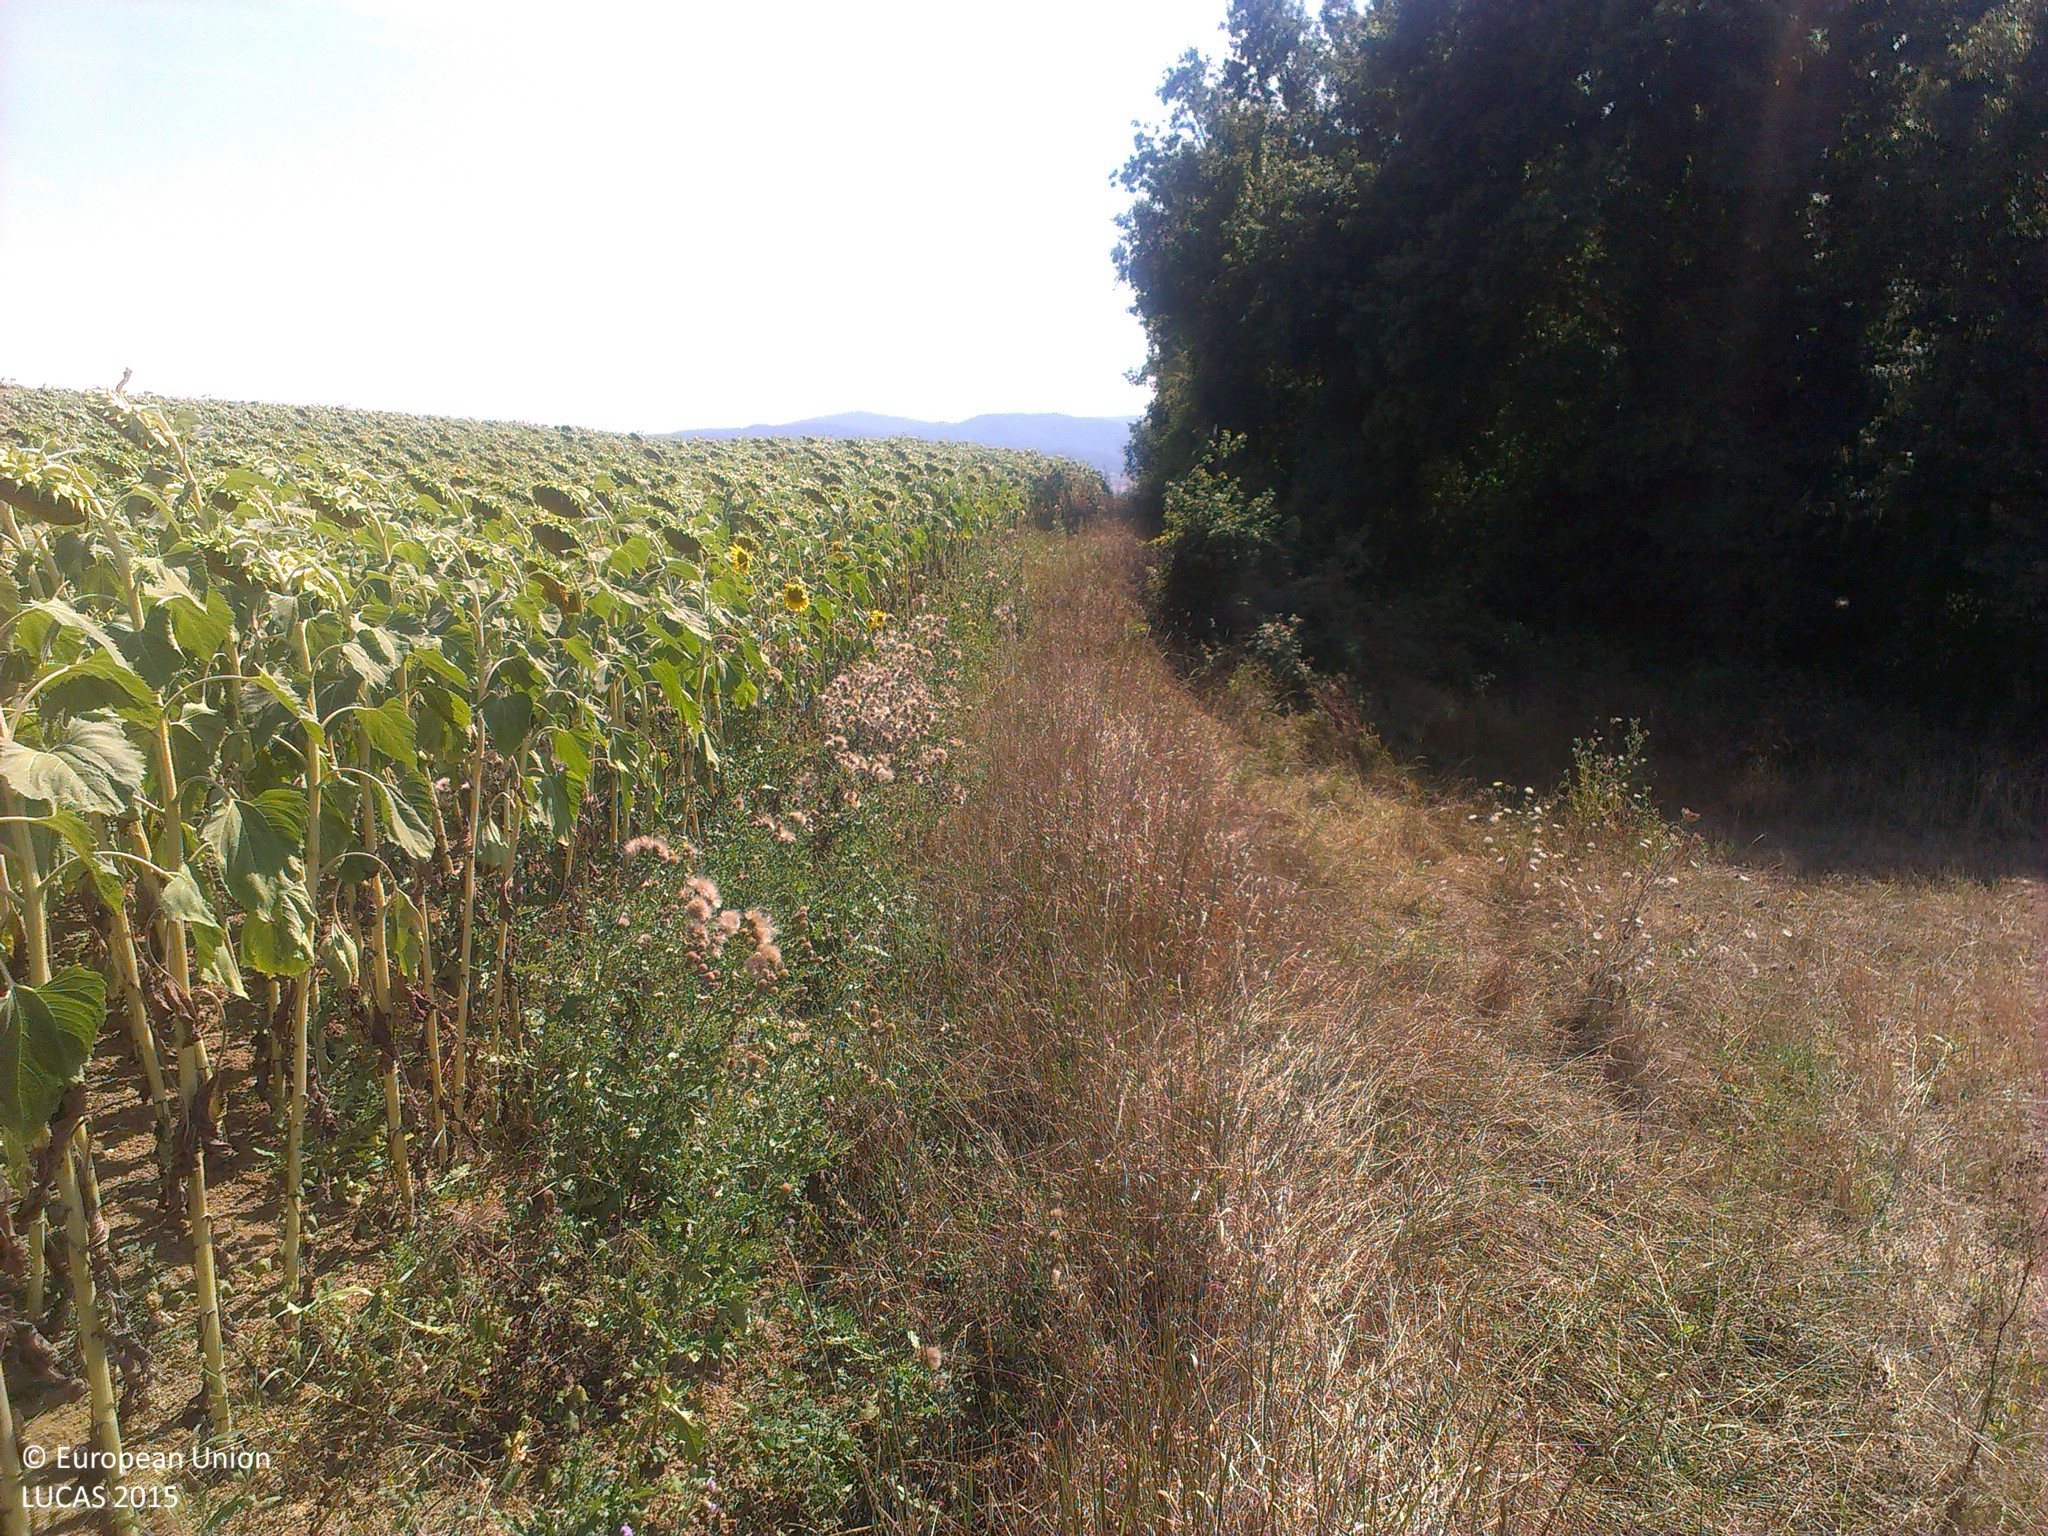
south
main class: Cropland
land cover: Sunflower
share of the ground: > 75 %
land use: Agriculture (excluding fallow land and kitchen gardens)
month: August
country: ES
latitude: 42.8593
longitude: -2.5209
